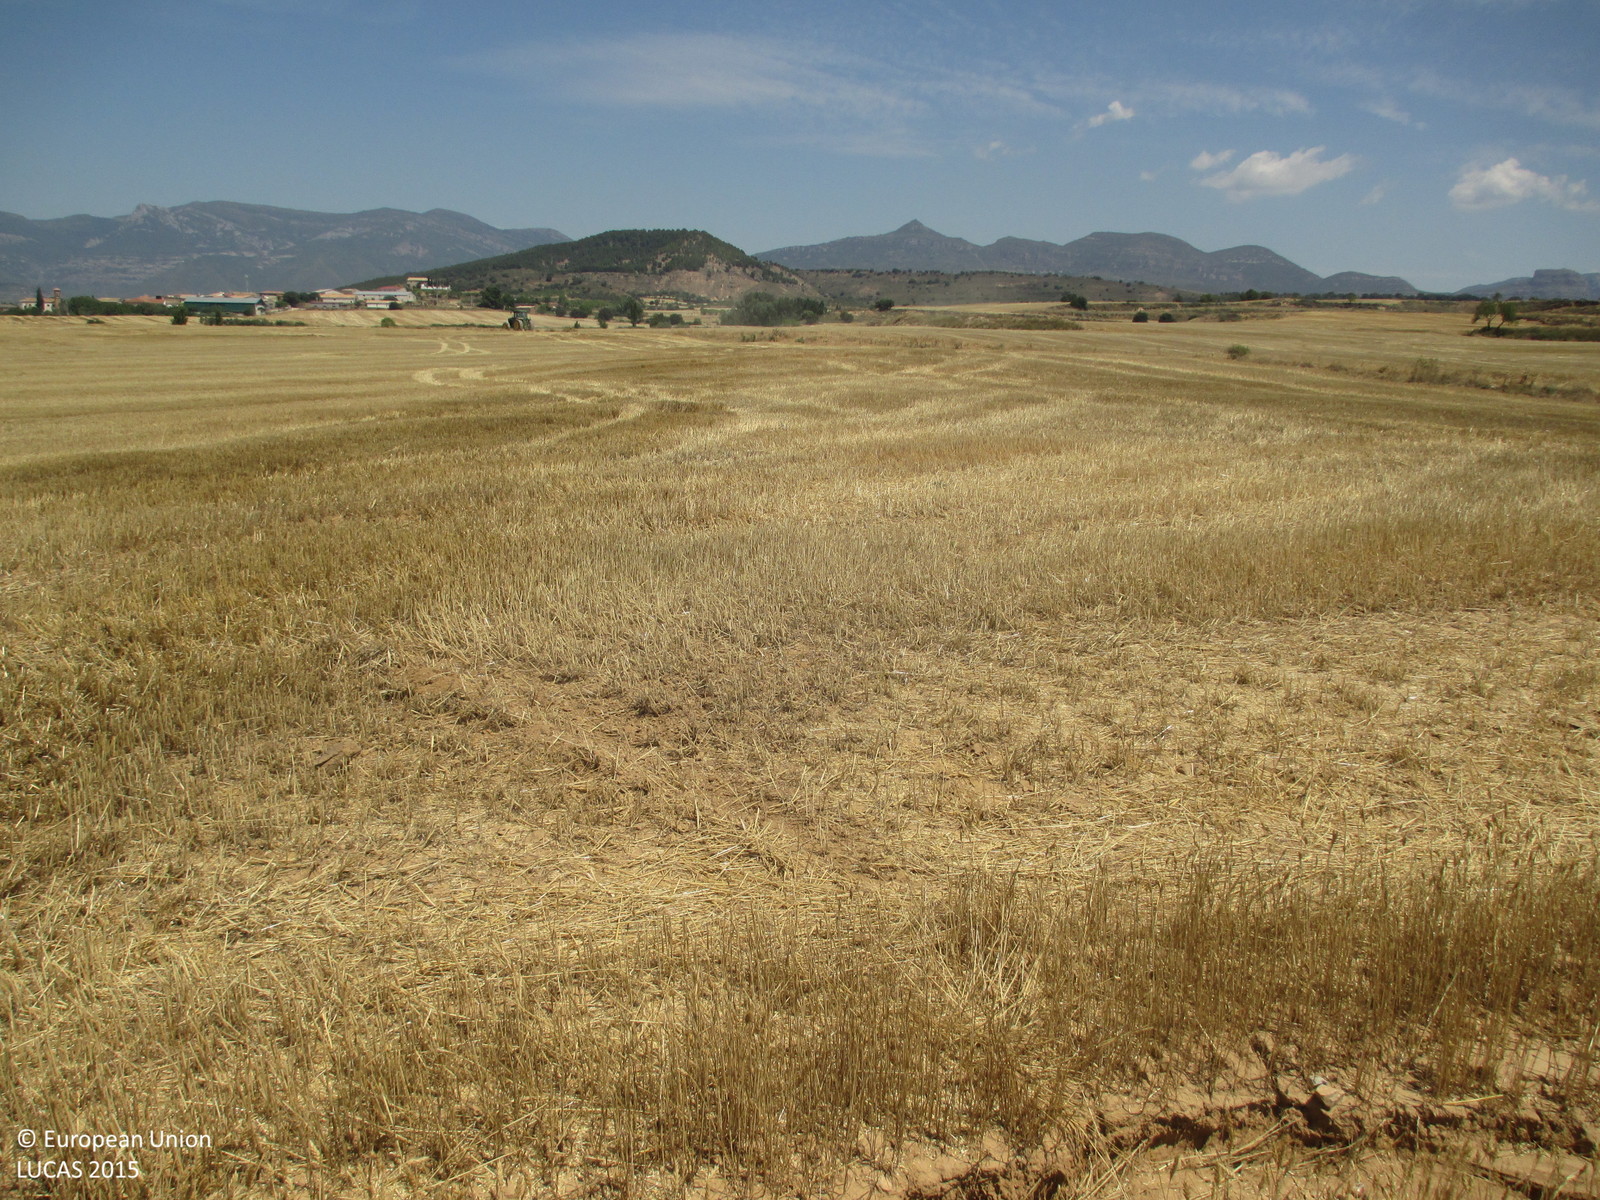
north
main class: Cropland
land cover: Common wheat
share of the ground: < 10 %
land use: Agriculture (excluding fallow land and kitchen gardens)
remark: Harvested field
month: June
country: ES
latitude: 42.2054
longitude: -0.4273
